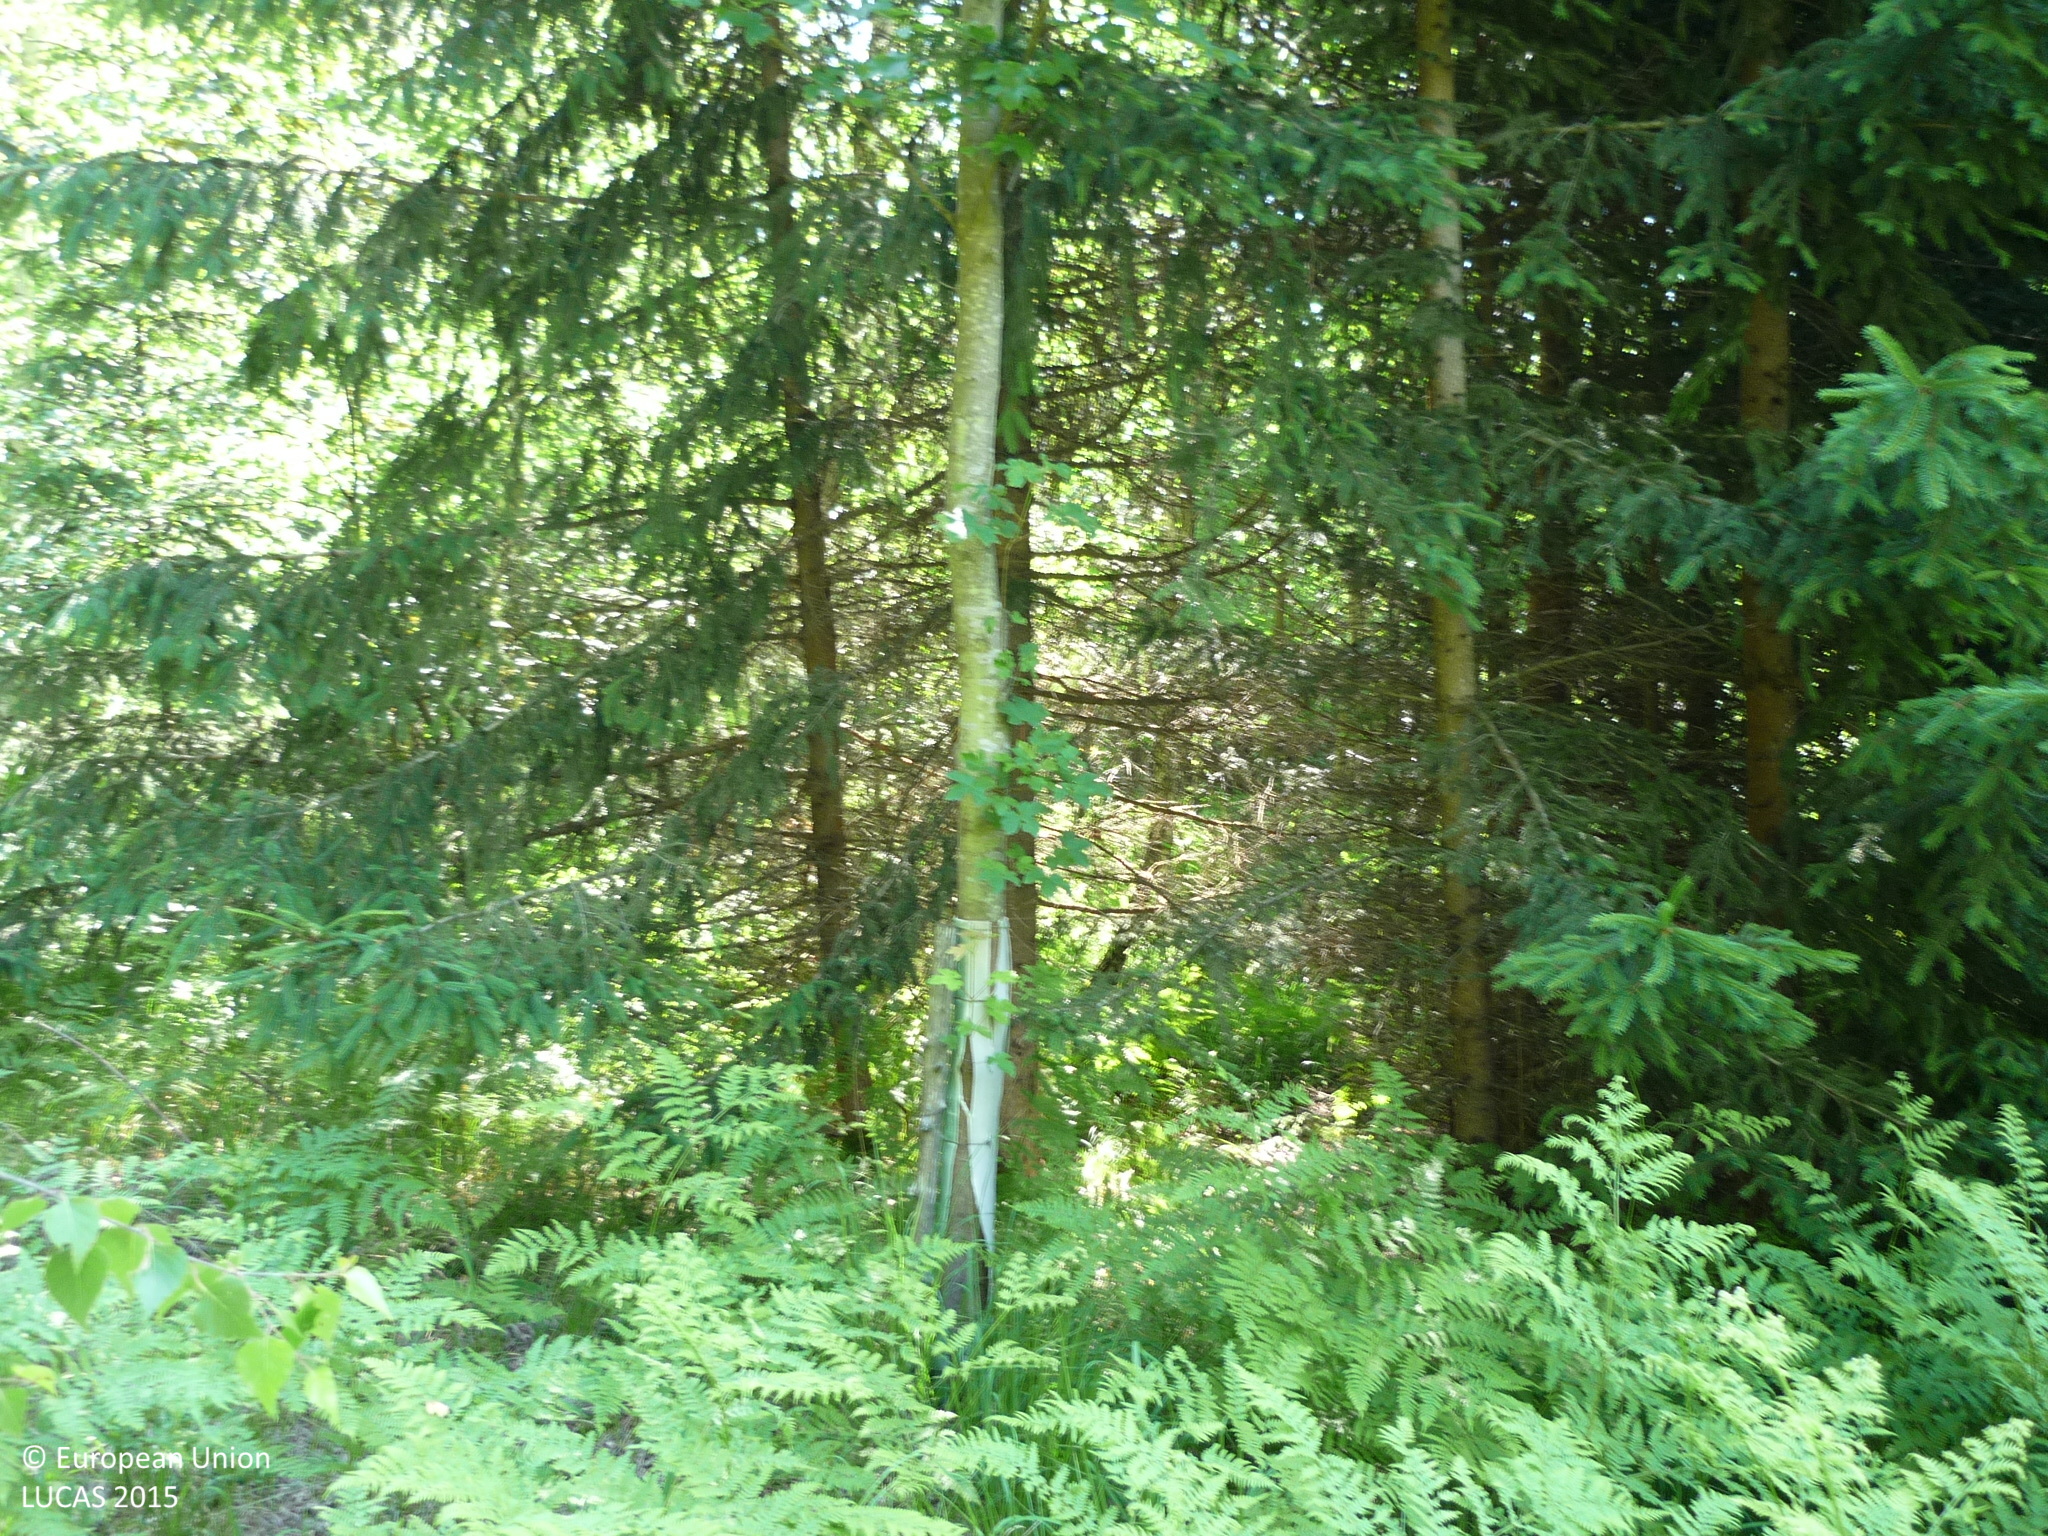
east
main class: Woodland
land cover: Broadleaved woodland
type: non-riverine alder, birch or aspen forest
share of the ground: > 75 %
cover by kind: broadleaved forest trees 50 %, herbaceous plants 40 %, unconsolidated bare surface 10 %
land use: Forestry
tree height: < 5 m
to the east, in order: Broadleaved woodland; Tracks; Spruce dominated coniferous woodland; Tracks; Spruce dominated coniferous woodland; Ditches and canals; Broadleaved woodland; Tracks; Broadleaved woodland; Artificial constructions in urban areas; Grassland without tree/shrub cover
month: June
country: AT
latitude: 46.7771
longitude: 15.6969
